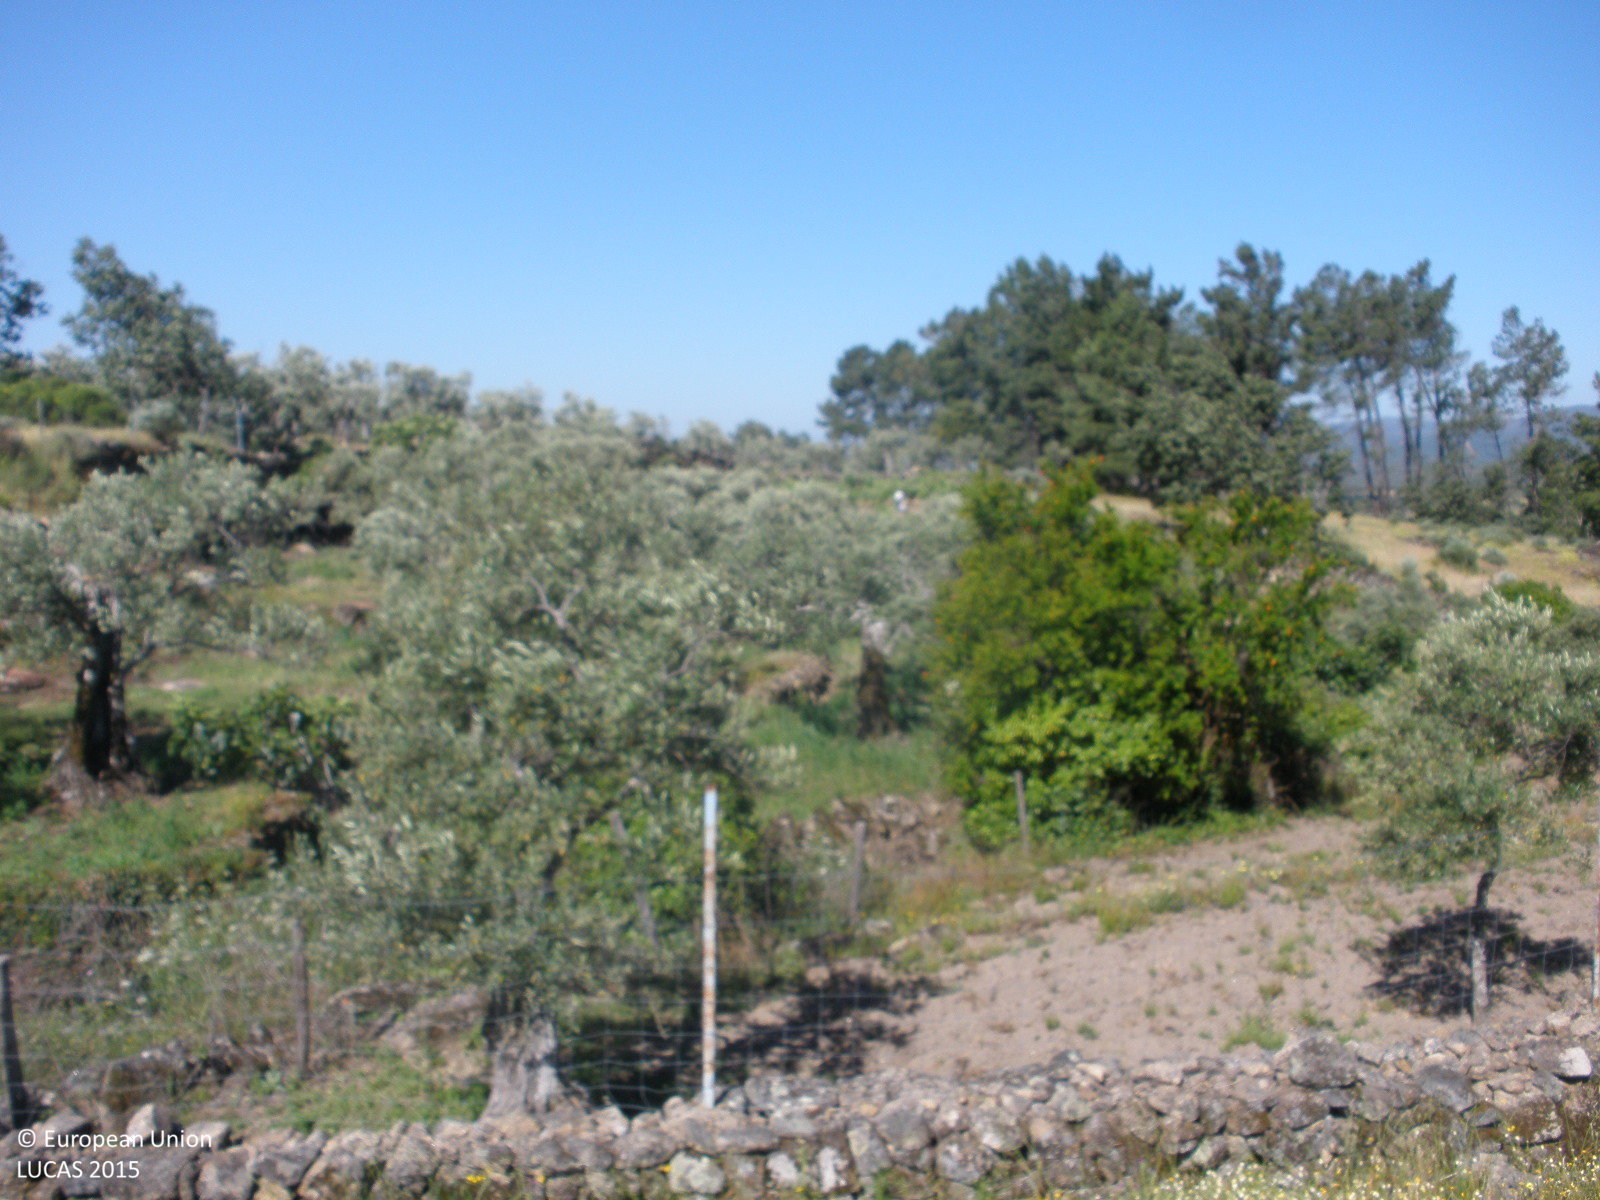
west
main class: Cropland
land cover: Olive groves
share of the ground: 50 - 75 %
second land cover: Spontaneously vegetated surfaces
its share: > 75 %
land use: Agriculture (excluding fallow land and kitchen gardens)
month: May
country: ES
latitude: 40.2062
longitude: -6.8080
